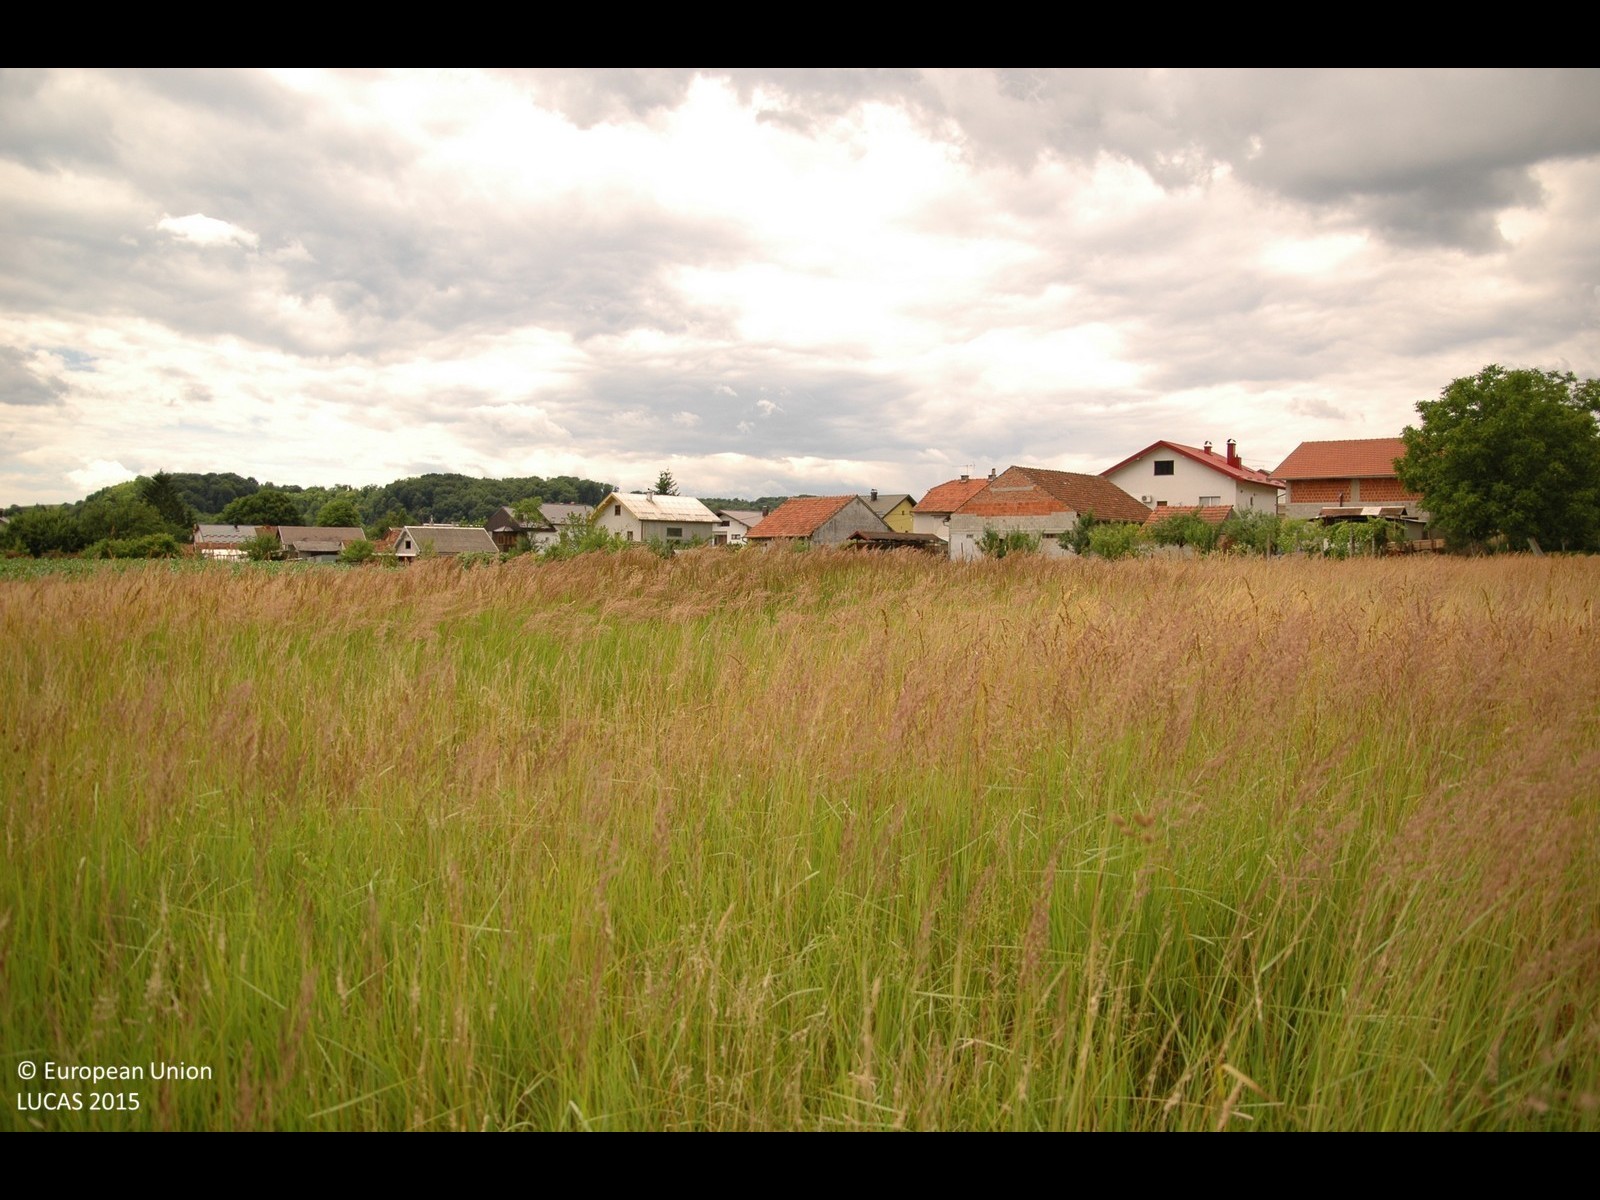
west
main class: Grassland
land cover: Grassland without tree/shrub cover
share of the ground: > 75 %
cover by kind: herbaceous plants 100 %
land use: Agriculture (excluding fallow land and kitchen gardens)
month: June
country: HR
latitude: 46.1348
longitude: 15.8880
